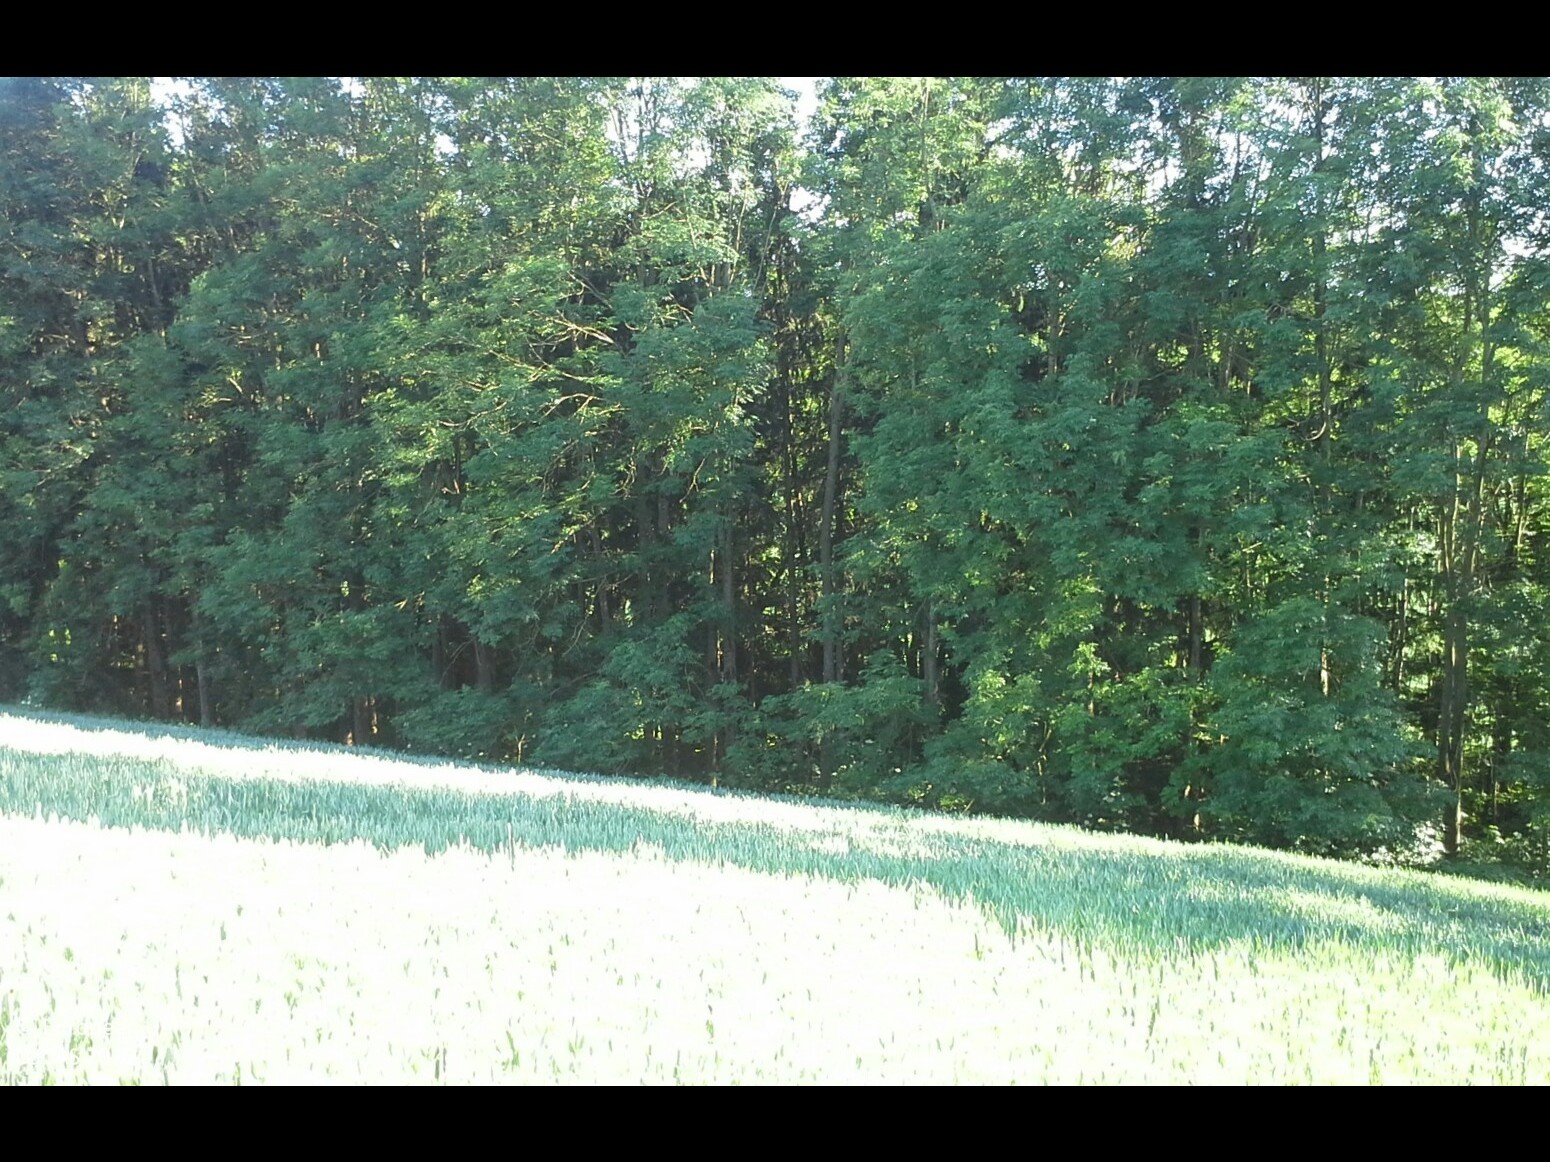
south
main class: Cropland
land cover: Common wheat
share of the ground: > 75 %
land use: Agriculture (excluding fallow land and kitchen gardens)
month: June
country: AT
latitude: 48.1227
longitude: 14.7160
